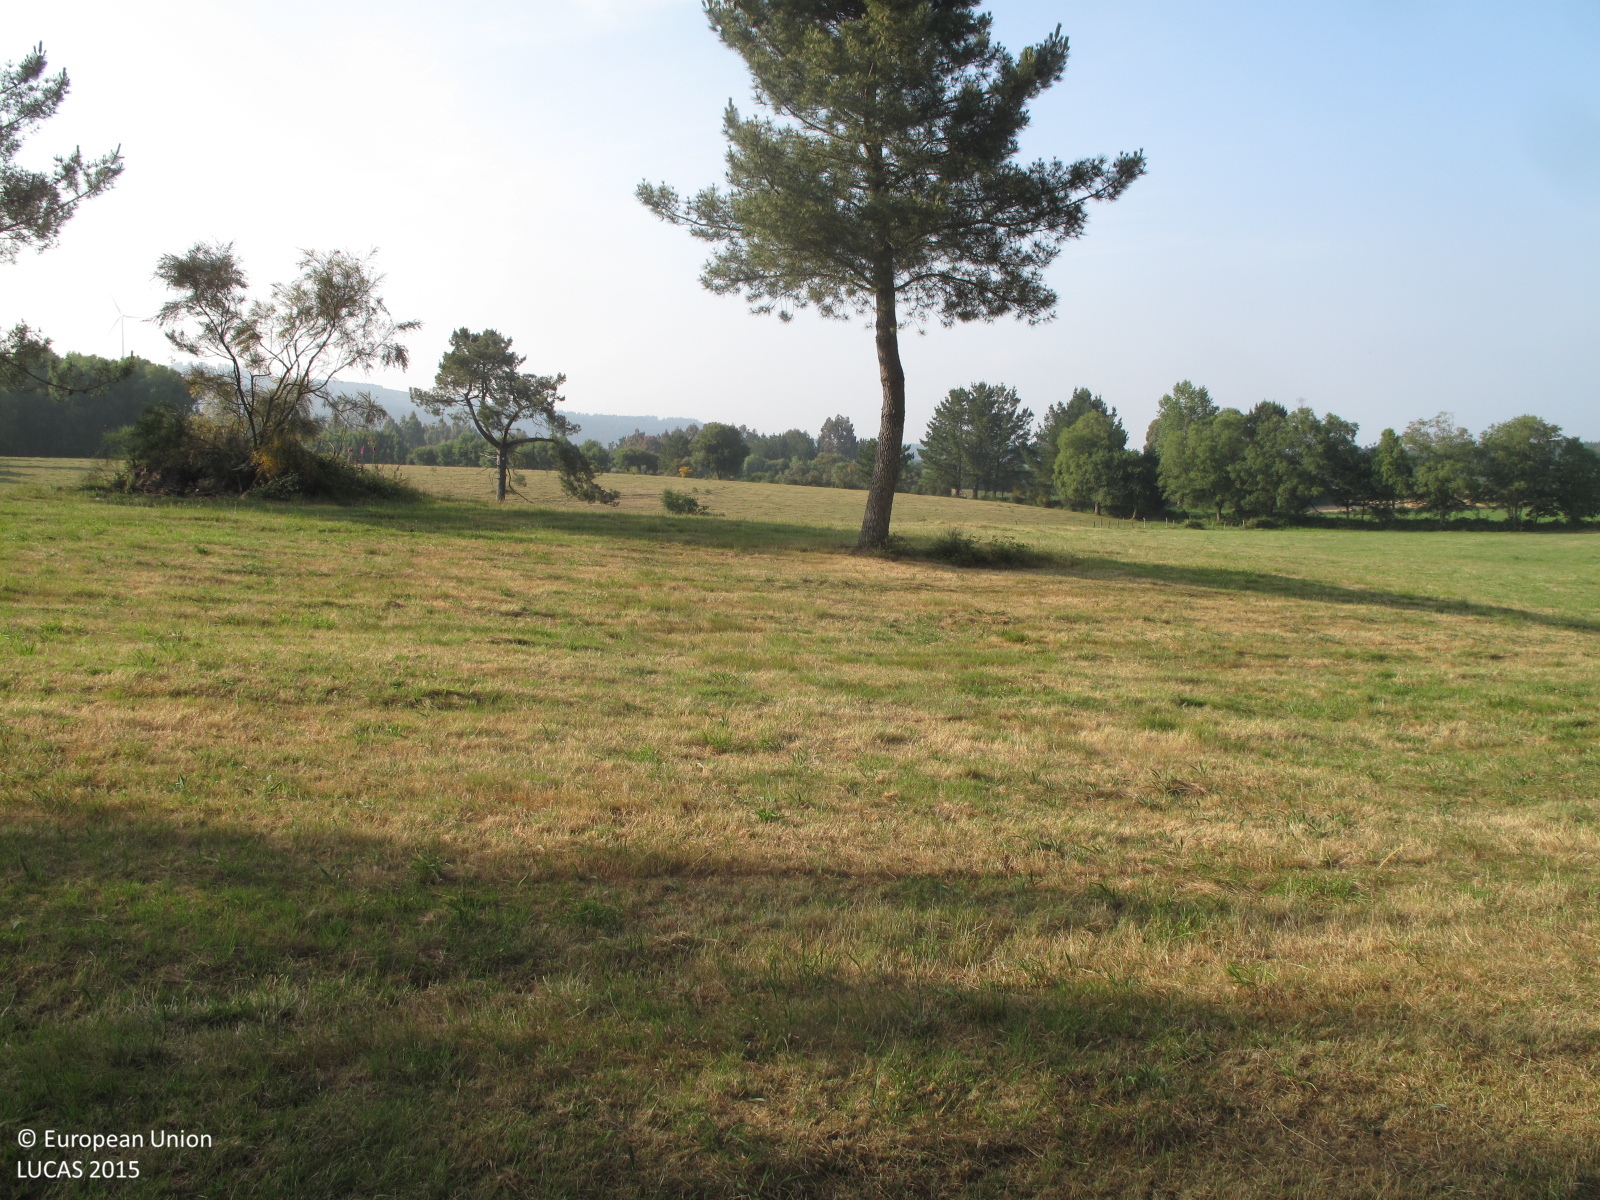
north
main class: Grassland
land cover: Grassland without tree/shrub cover
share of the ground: > 75 %
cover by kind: herbaceous plants 100 %
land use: Agriculture (excluding fallow land and kitchen gardens)
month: June
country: ES
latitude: 43.0764
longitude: -7.8839
